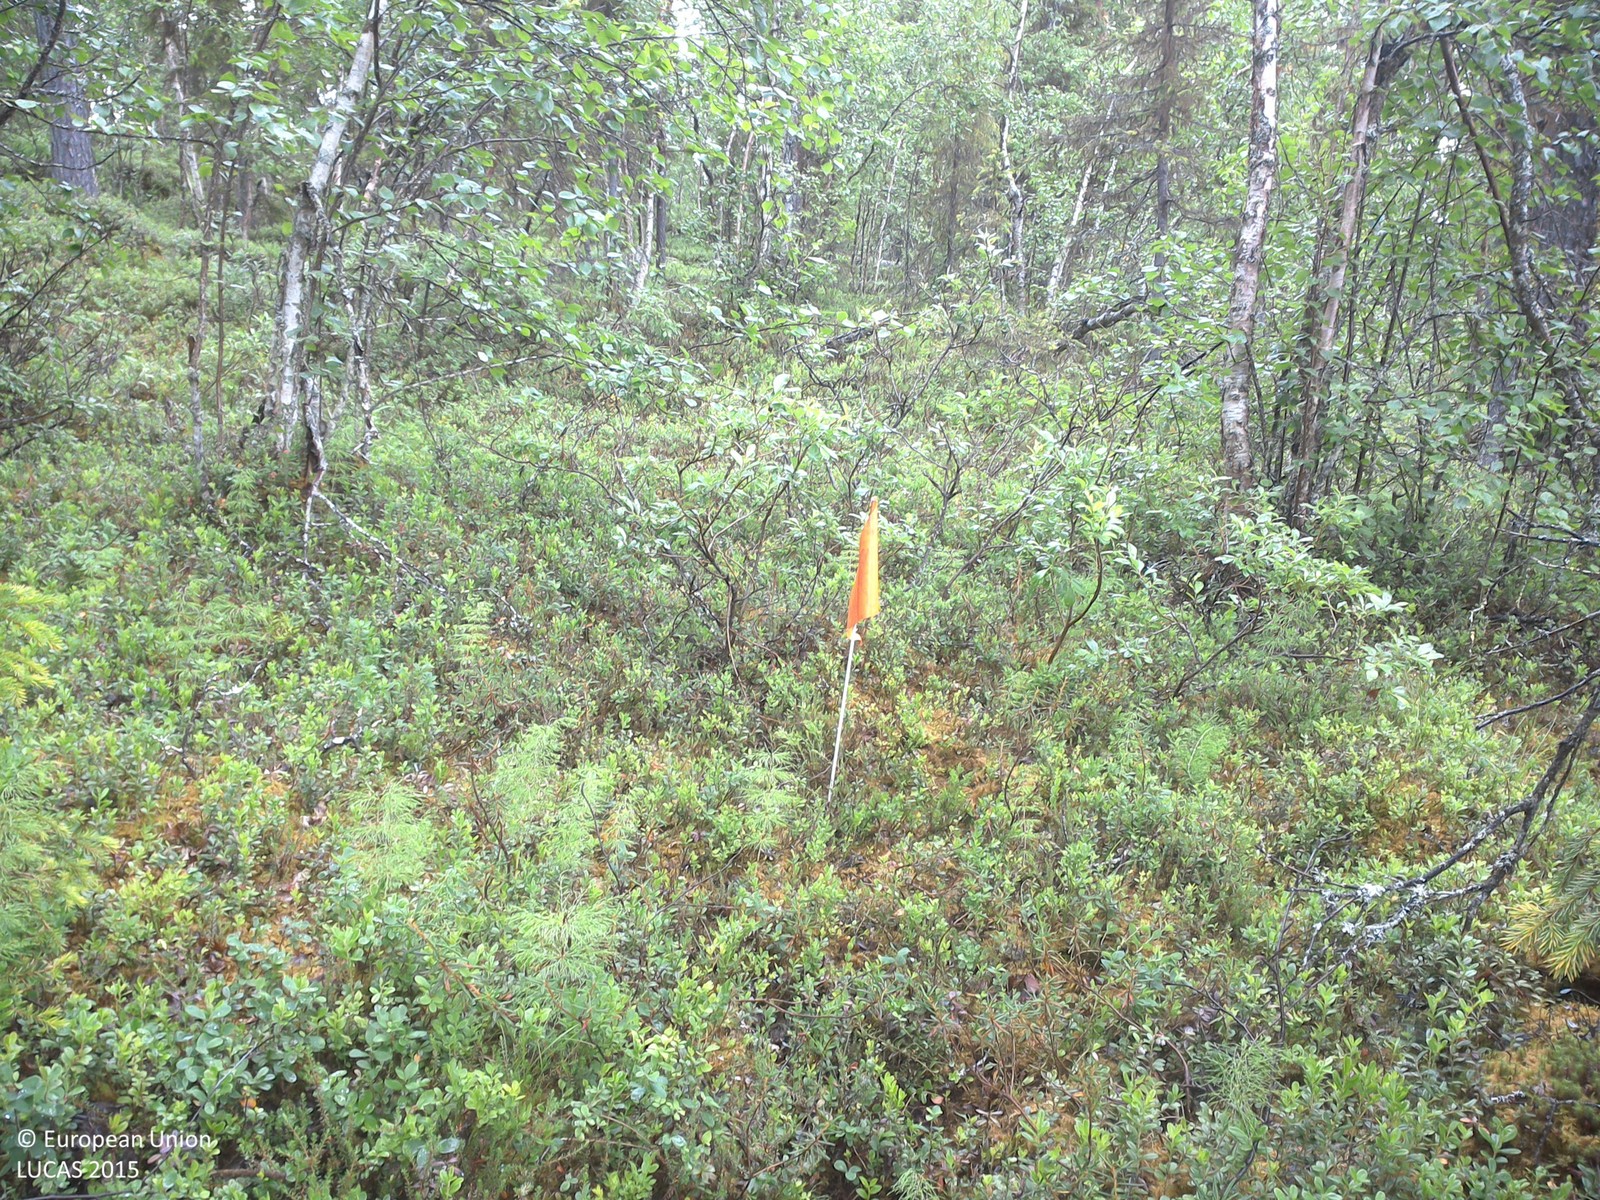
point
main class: Woodland
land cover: Spruce dominated mixed woodland
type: boreal forest
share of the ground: 25 - 50 %
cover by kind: shrubs 55 %, coniferous forest trees 25 %, broadleaved forest trees 15 %, lichens and mosses 5 %
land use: Forestry
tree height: > 5 m
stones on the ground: < 10 %
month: July
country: SE
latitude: 67.8173
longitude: 23.4683
